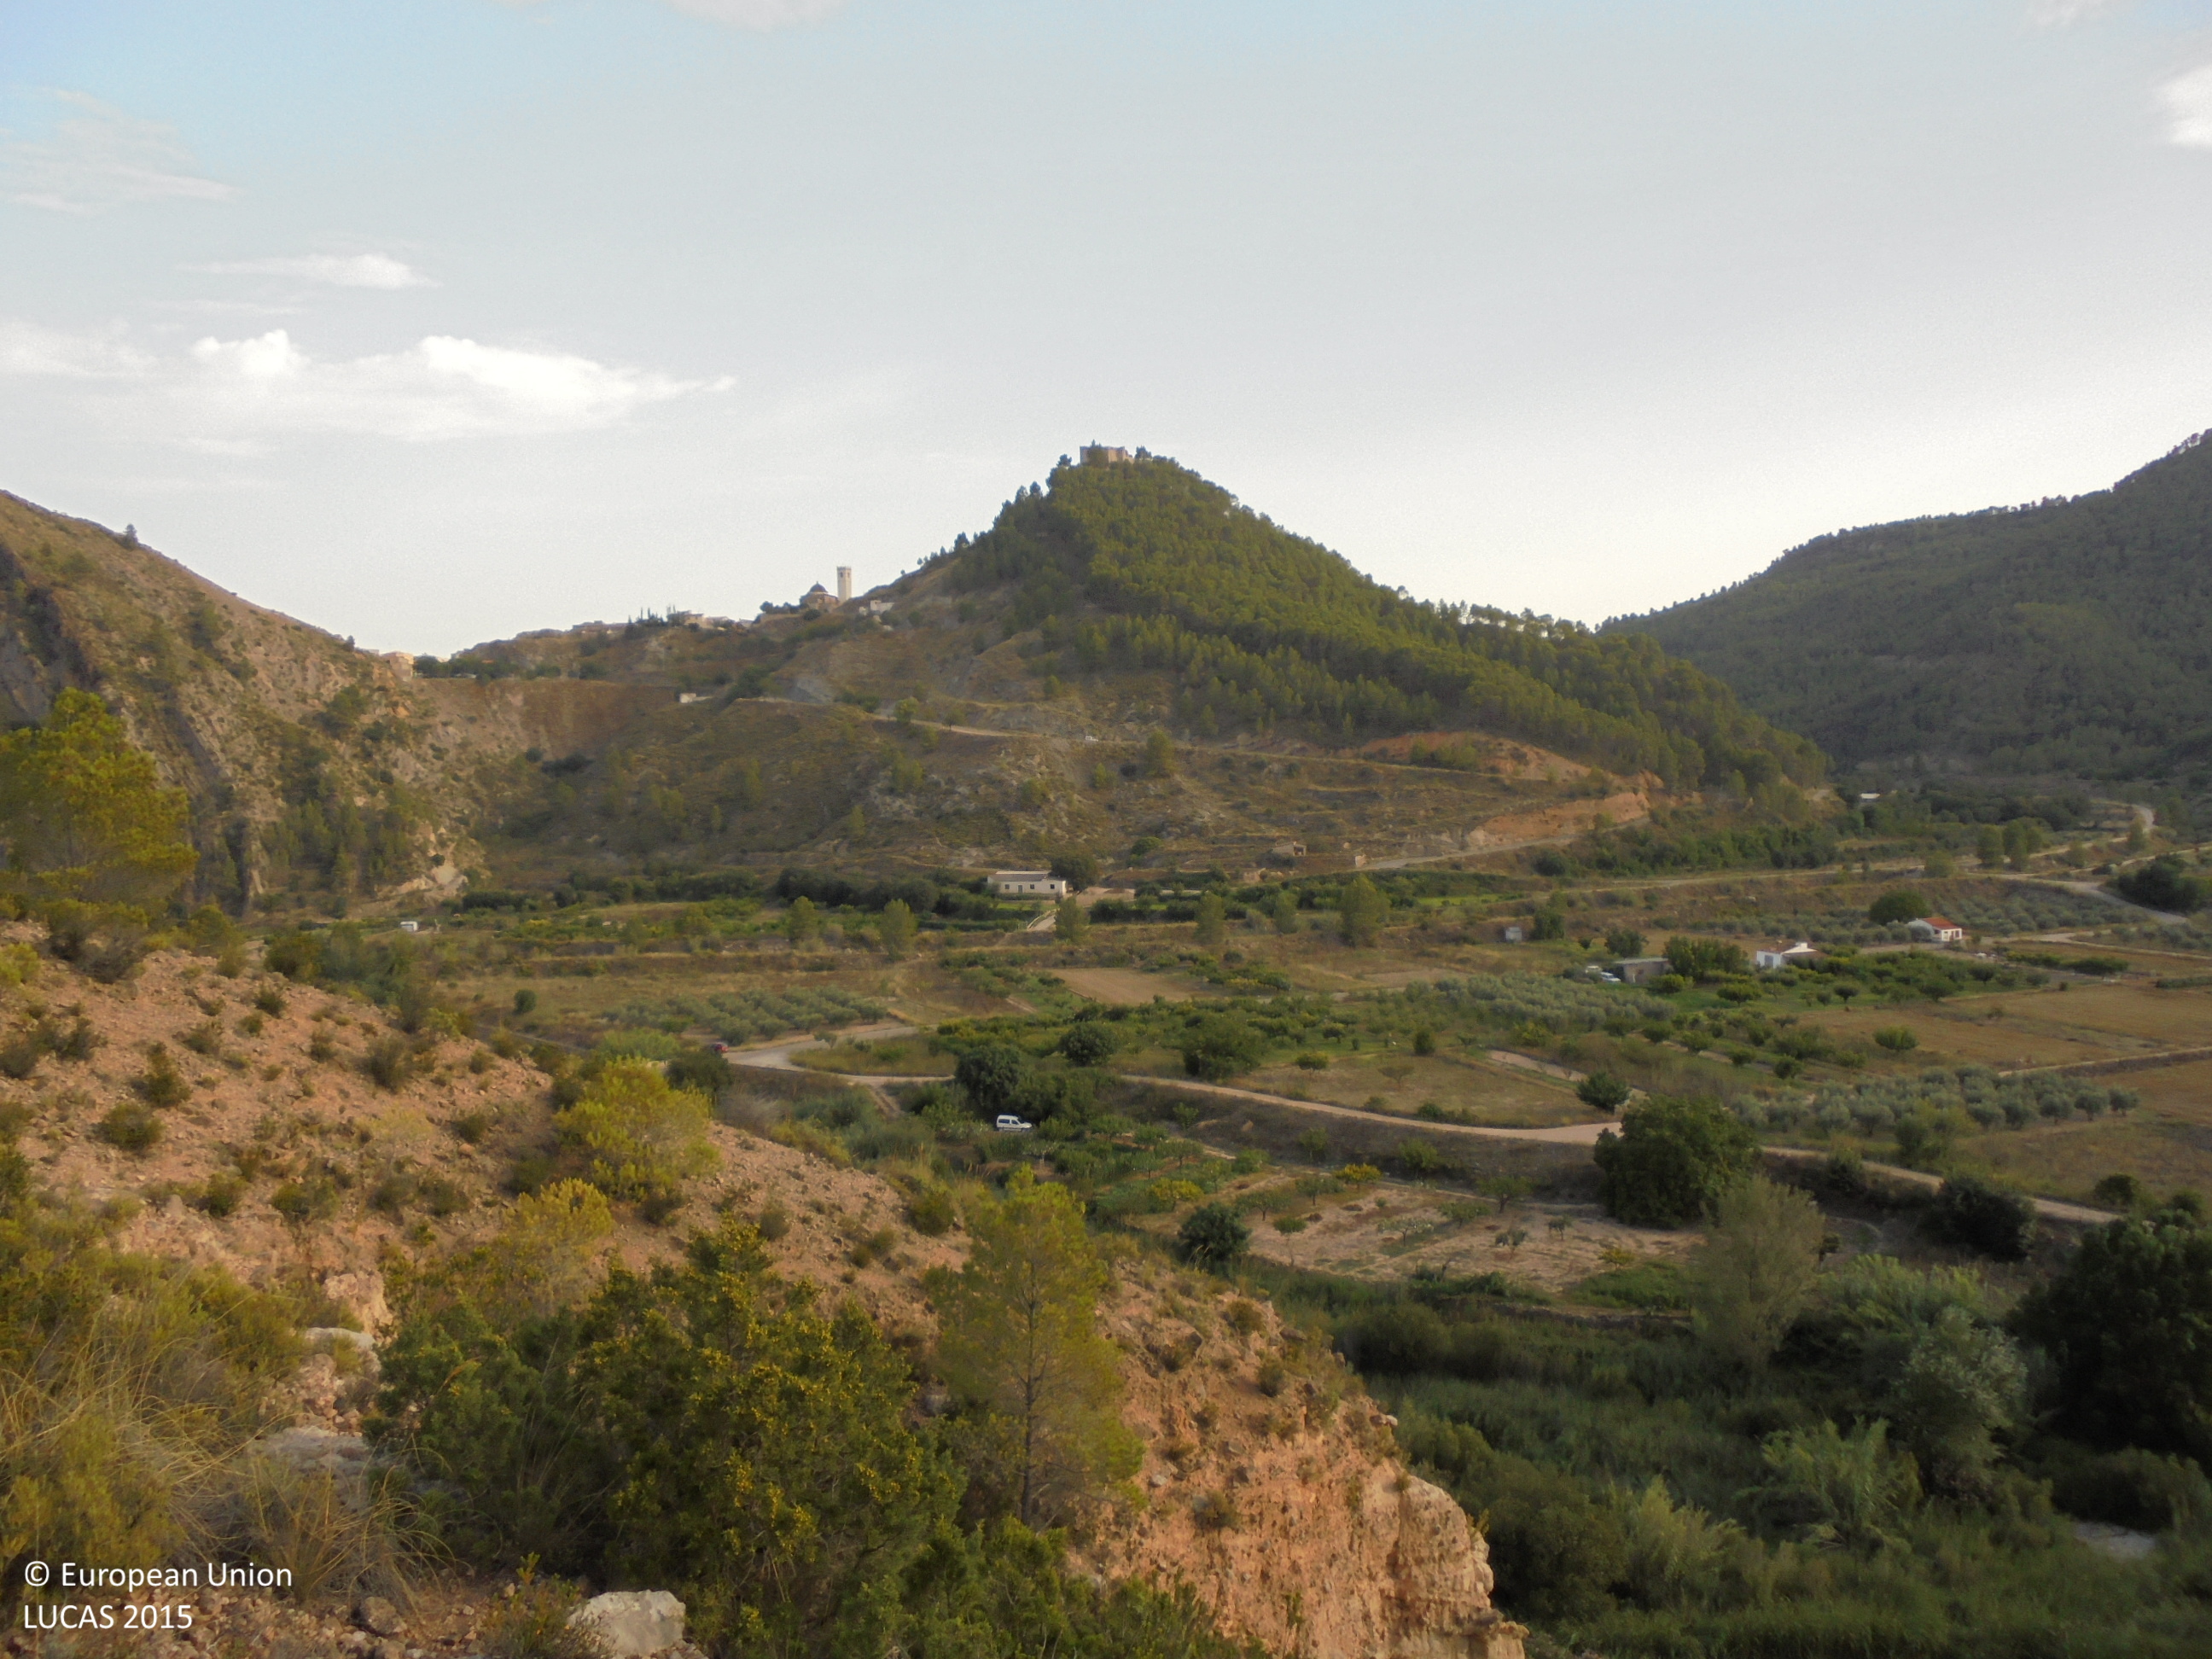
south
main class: Shrubland
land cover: Shrubland with sparse tree cover
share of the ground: > 75 %
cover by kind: shrubs 80 %, unconsolidated bare surface 15 %, coniferous forest trees 5 %
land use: Semi-natural and natural areas not in use
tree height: > 5 m
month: August
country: ES
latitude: 39.1997
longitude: -1.0793
